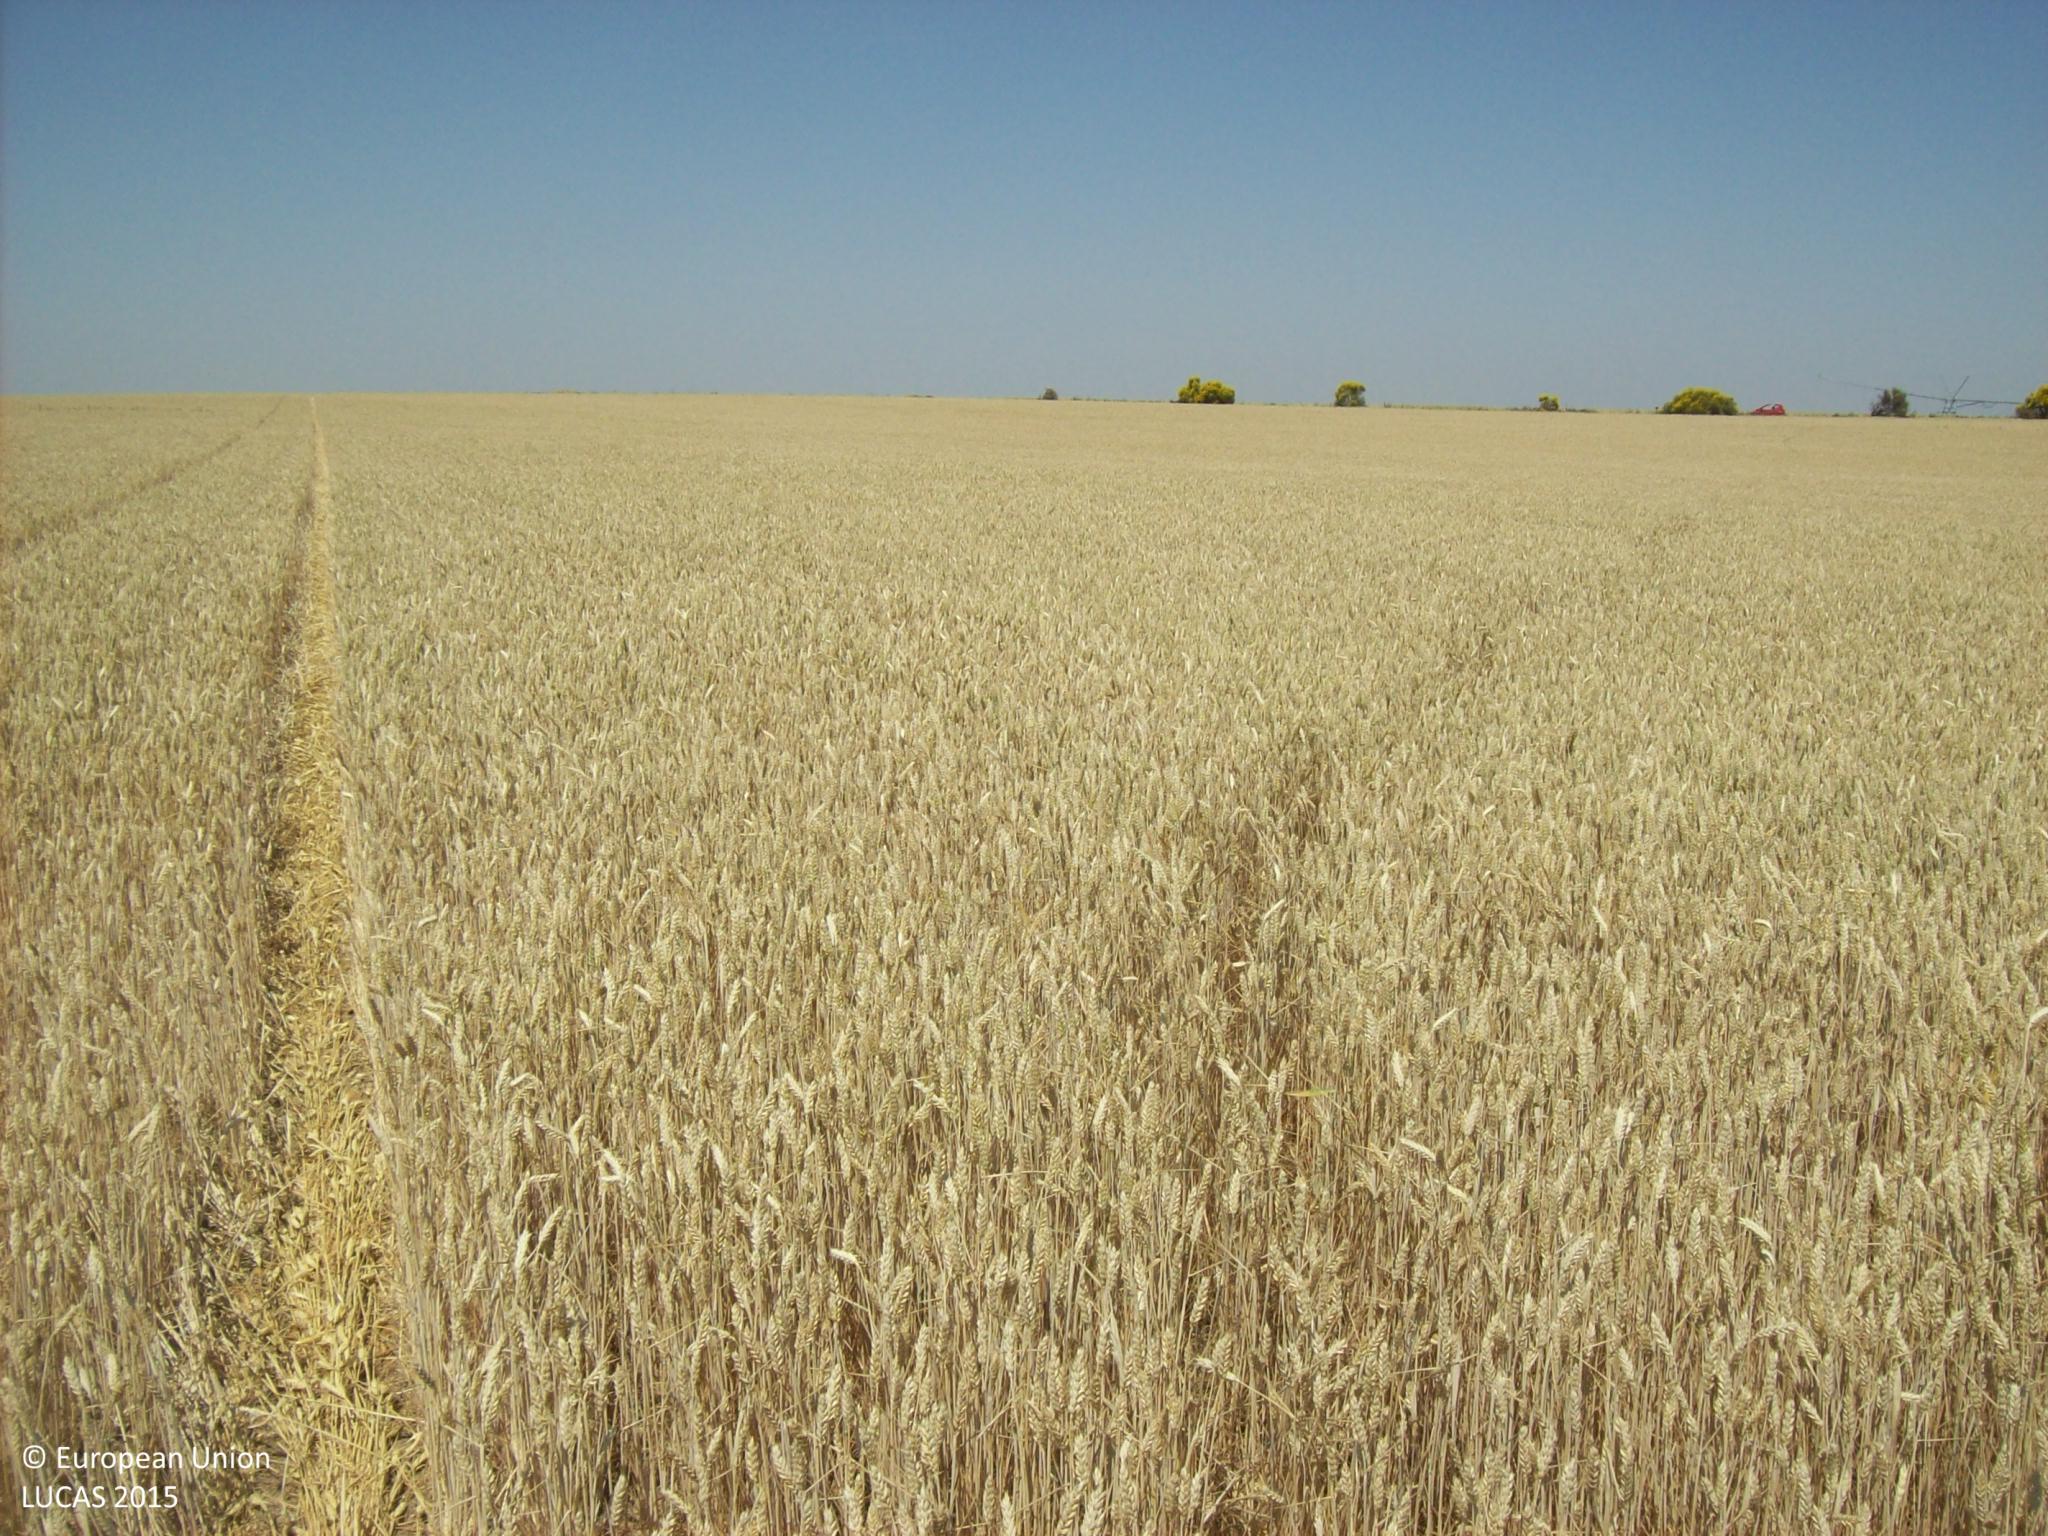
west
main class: Cropland
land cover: Common wheat
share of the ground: > 75 %
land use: Agriculture (excluding fallow land and kitchen gardens)
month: June
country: ES
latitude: 41.1910
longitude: -5.0561
